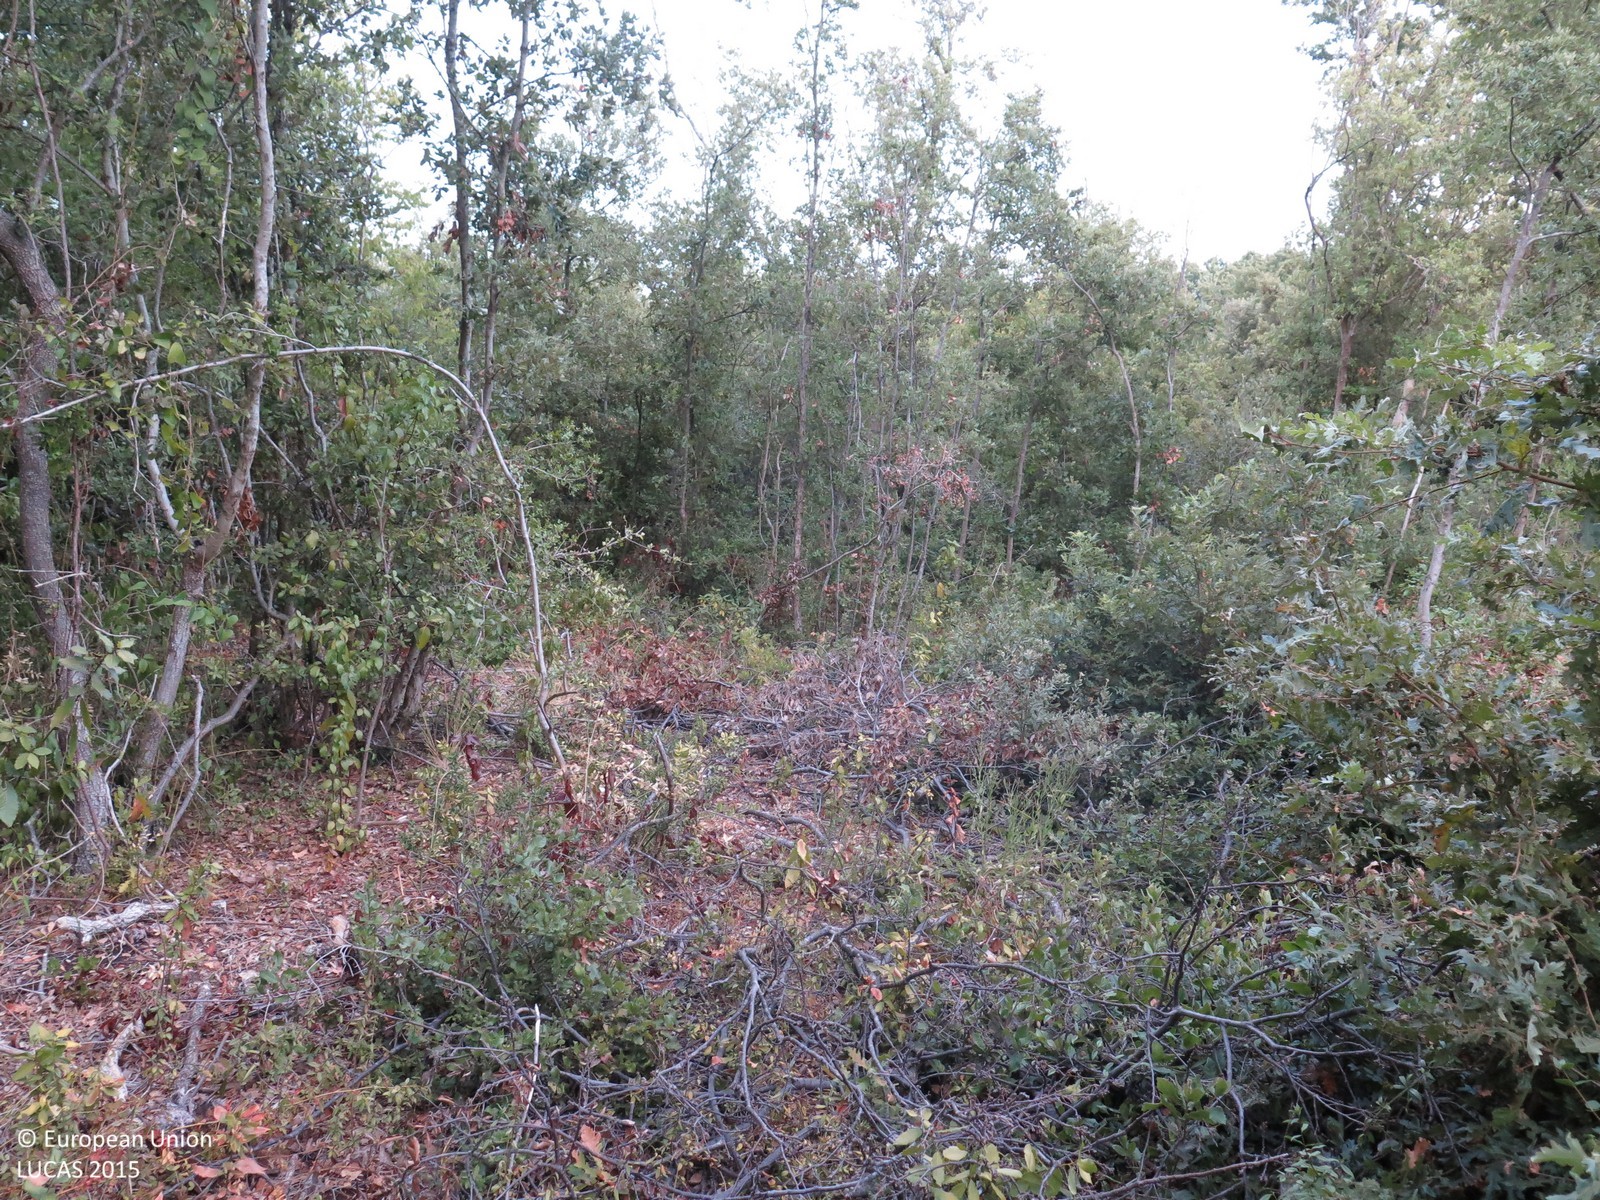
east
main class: Shrubland
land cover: Shrubland with sparse tree cover
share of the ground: > 75 %
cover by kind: shrubs 85 %, broadleaved forest trees 5 %, herbaceous plants 5 %, unconsolidated bare surface 5 %
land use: Semi-natural and natural areas not in use
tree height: > 5 m
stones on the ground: 10 - 25 %
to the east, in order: Shrubland with sparse tree cover; Broadleaved woodland
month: August
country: HR
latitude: 44.9220
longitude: 14.0354
